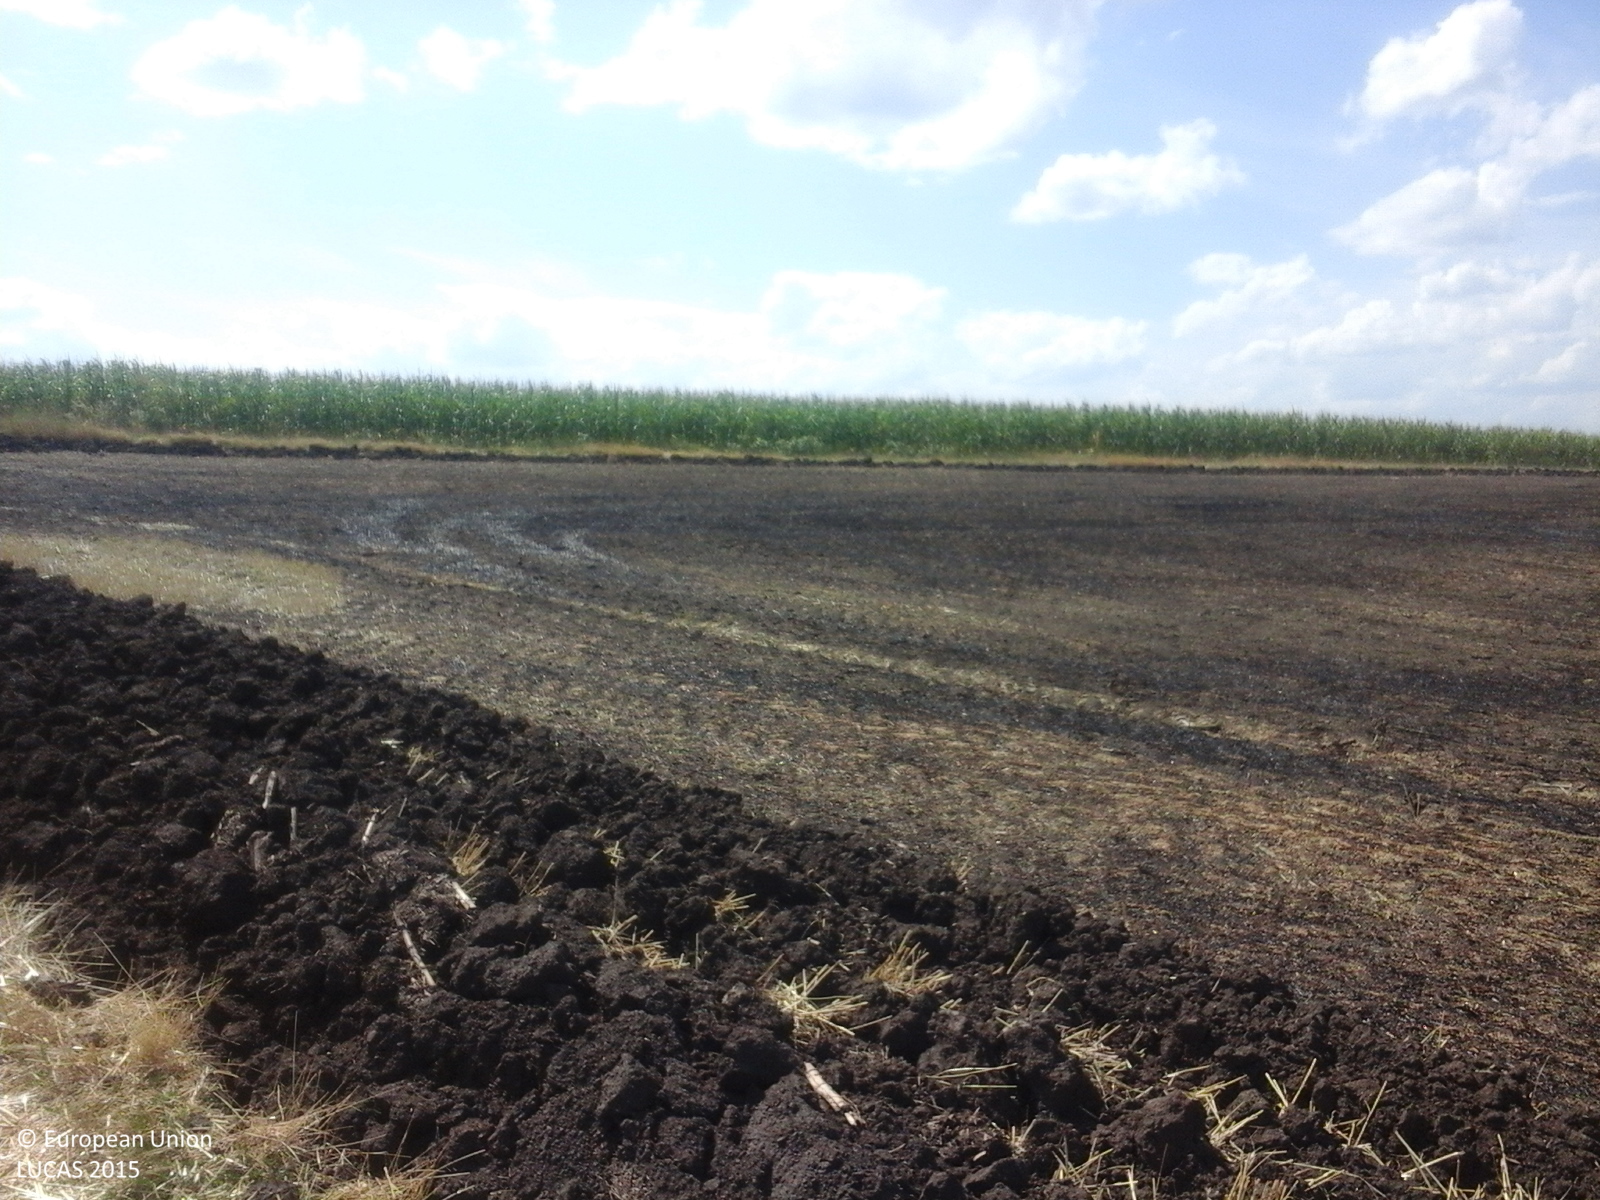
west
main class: Cropland
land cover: Maize
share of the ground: > 75 %
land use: Agriculture (excluding fallow land and kitchen gardens)
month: July
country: RO
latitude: 46.4705
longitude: 28.0880
